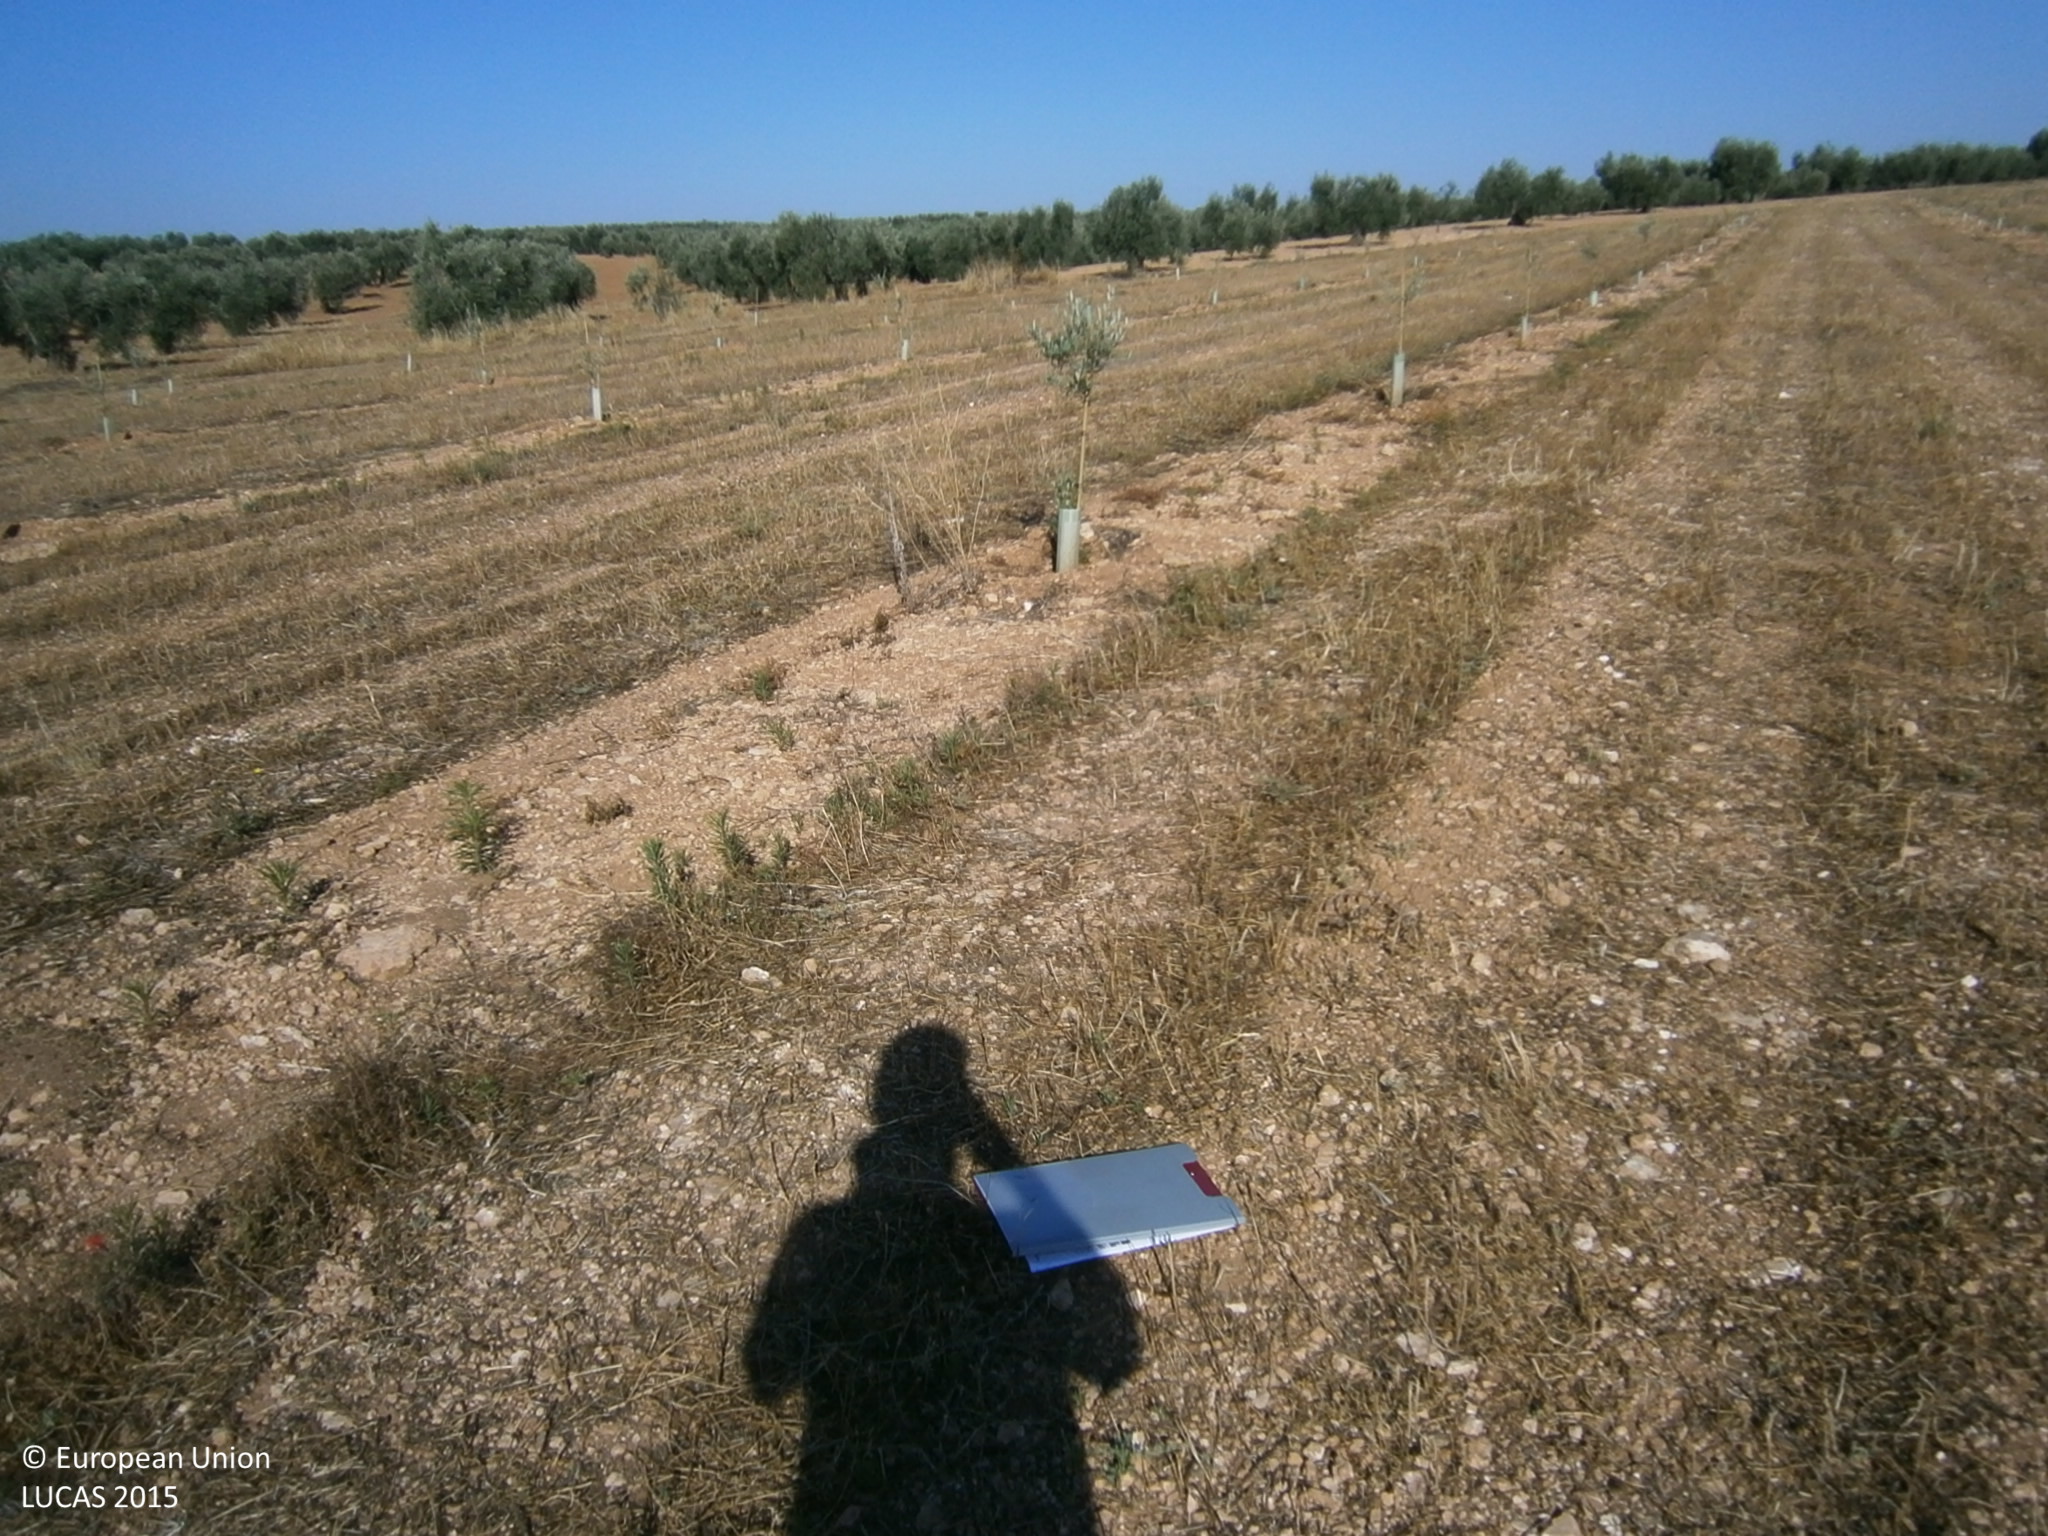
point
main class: Cropland
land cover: Olive groves
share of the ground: < 10 %
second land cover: Spontaneously vegetated surfaces
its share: > 75 %
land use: Agriculture (excluding fallow land and kitchen gardens)
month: June
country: ES
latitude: 38.6998
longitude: -6.6754
